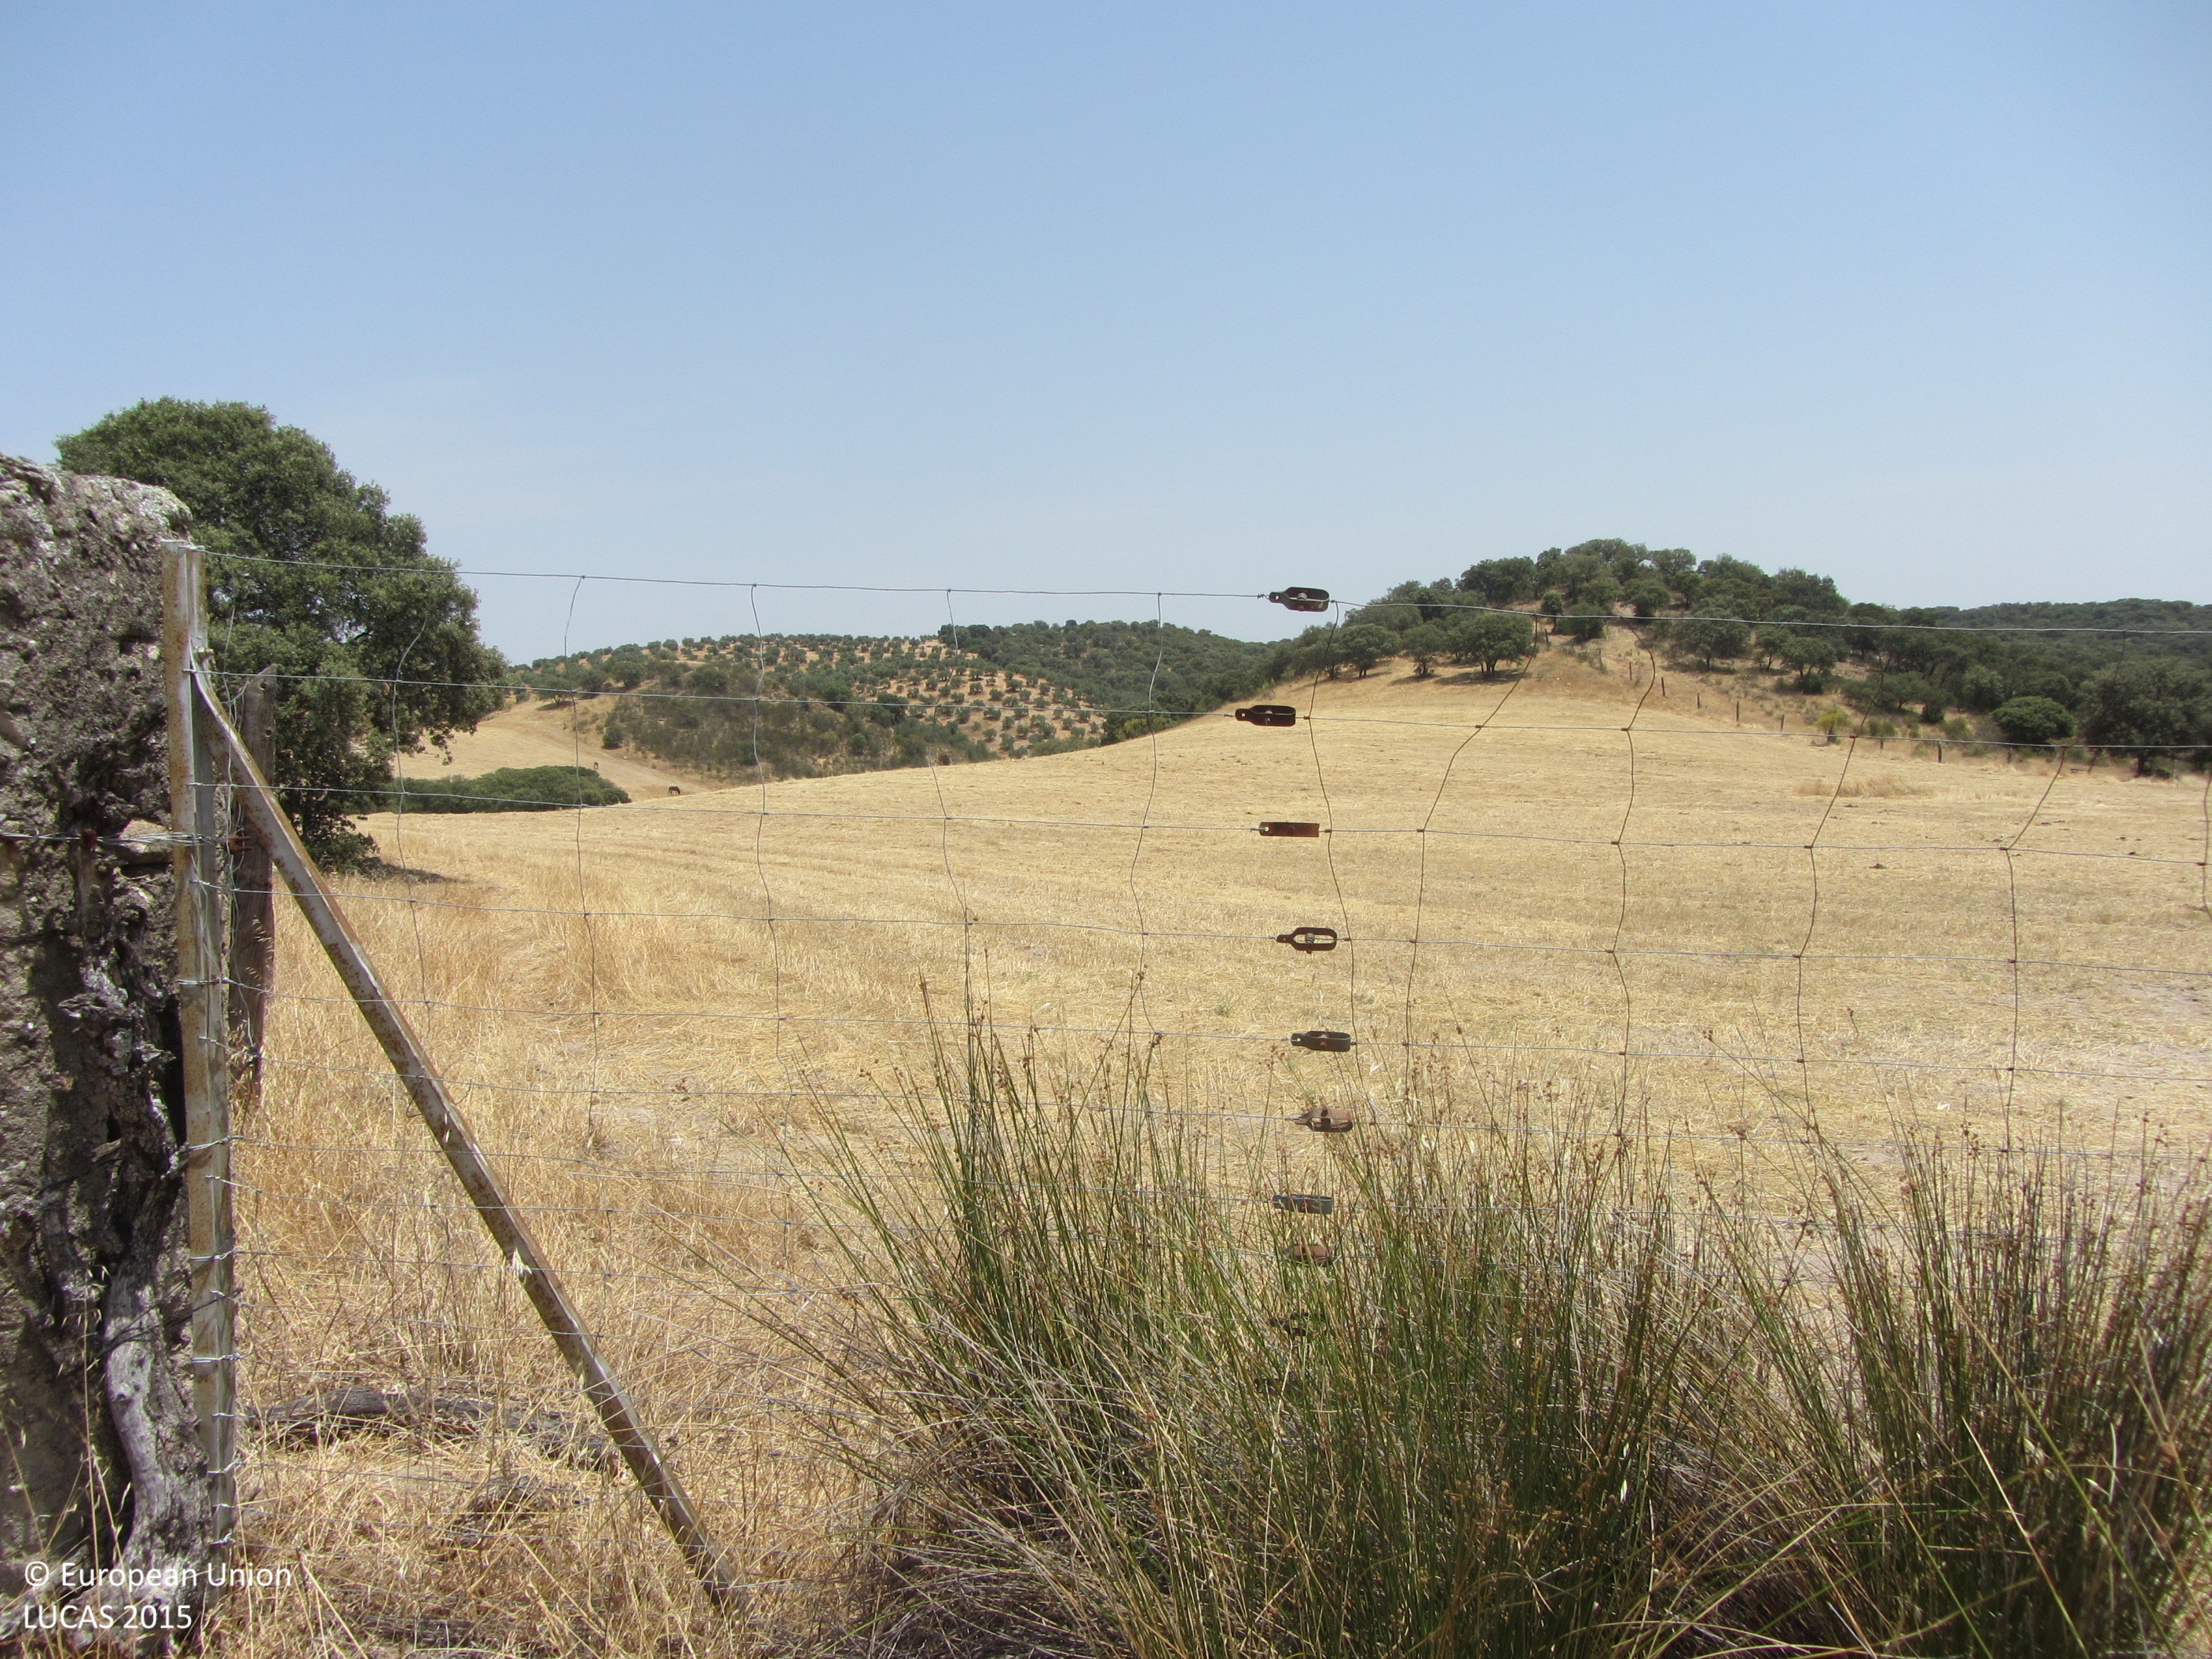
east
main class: Woodland
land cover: Broadleaved woodland
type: broadleaved evergreen forest
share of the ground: 25 - 50 %
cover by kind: herbaceous plants 40 %, broadleaved forest trees 35 %, shrubs 25 %
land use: Other primary production
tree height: > 5 m
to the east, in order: Broadleaved woodland; Rivers and streams; Broadleaved woodland; Tracks; Broadleaved woodland
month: July
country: ES
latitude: 38.1575
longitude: -3.8736
